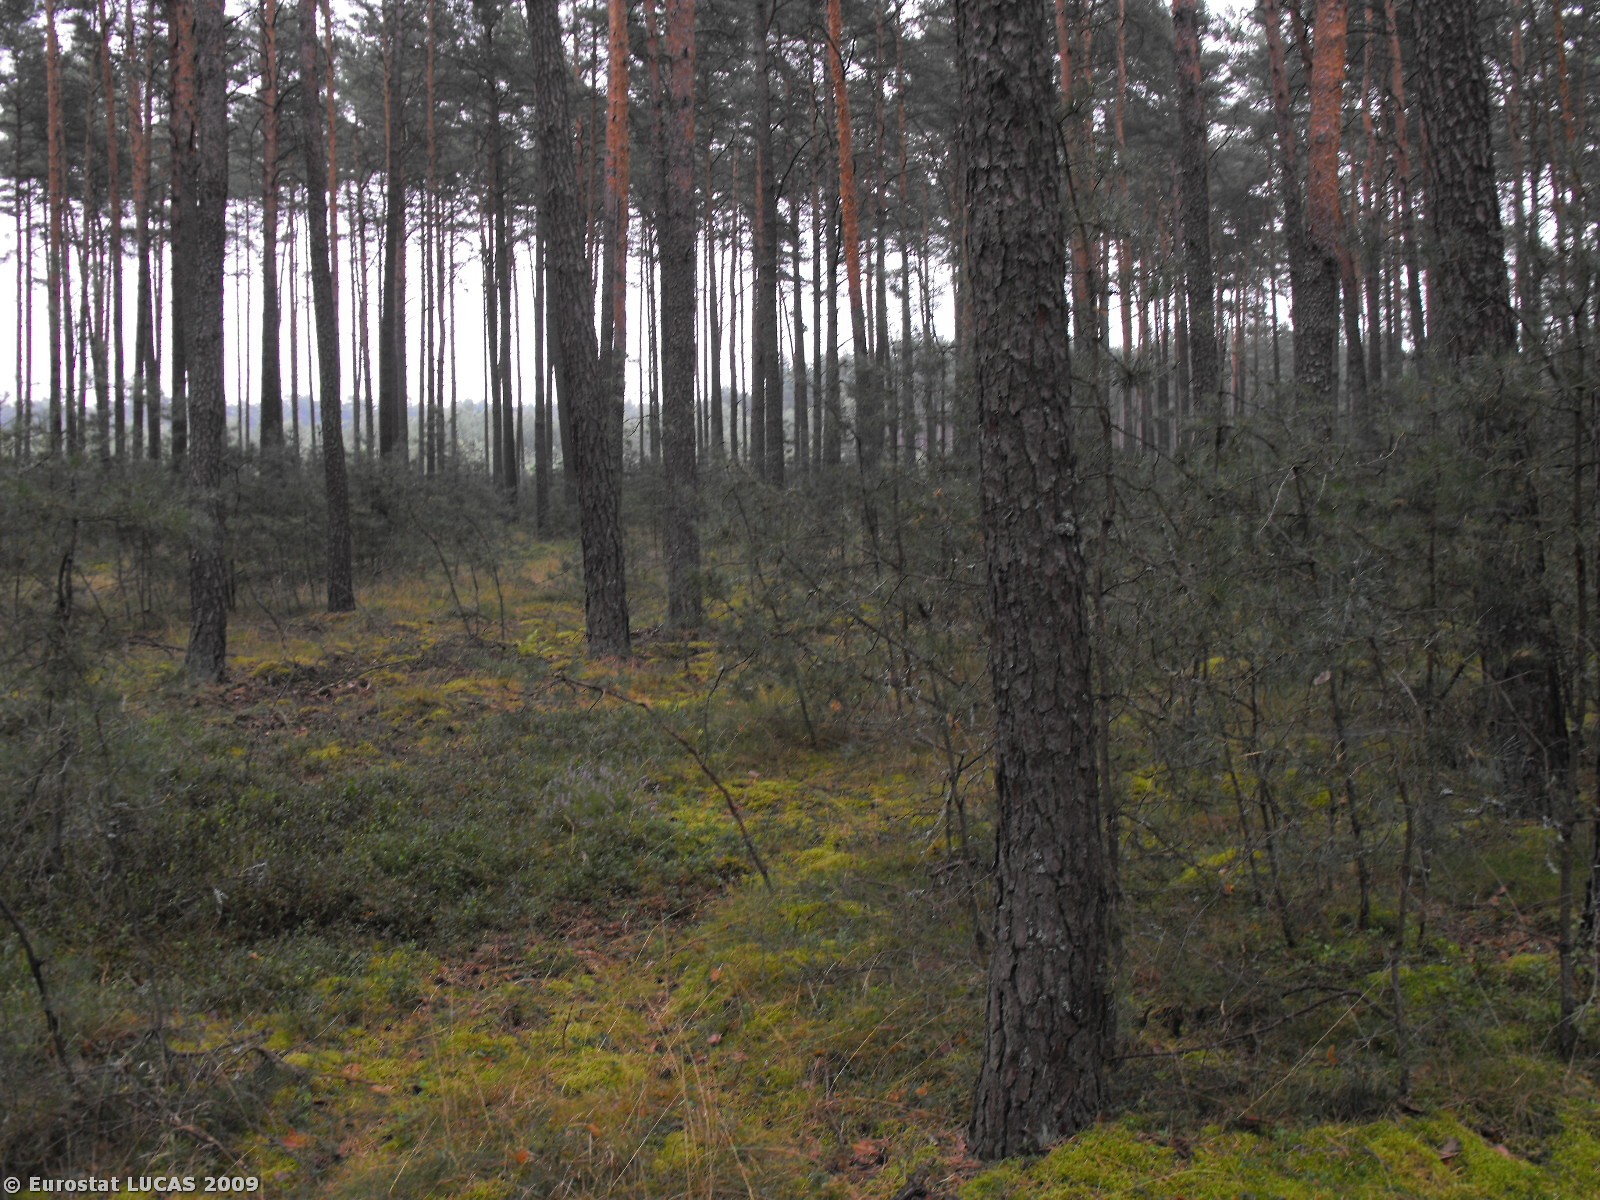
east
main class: Woodland
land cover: Coniferous woodland
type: hemiboreal forest and nemoral coniferous forest and mixed broadleaved-coniferous forest
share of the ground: > 75 %
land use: Forestry
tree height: > 5 m
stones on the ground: < 10 %
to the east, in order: Coniferous woodland; Tracks; Mixed woodland
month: September
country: PL
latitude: 52.9430
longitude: 16.4206
